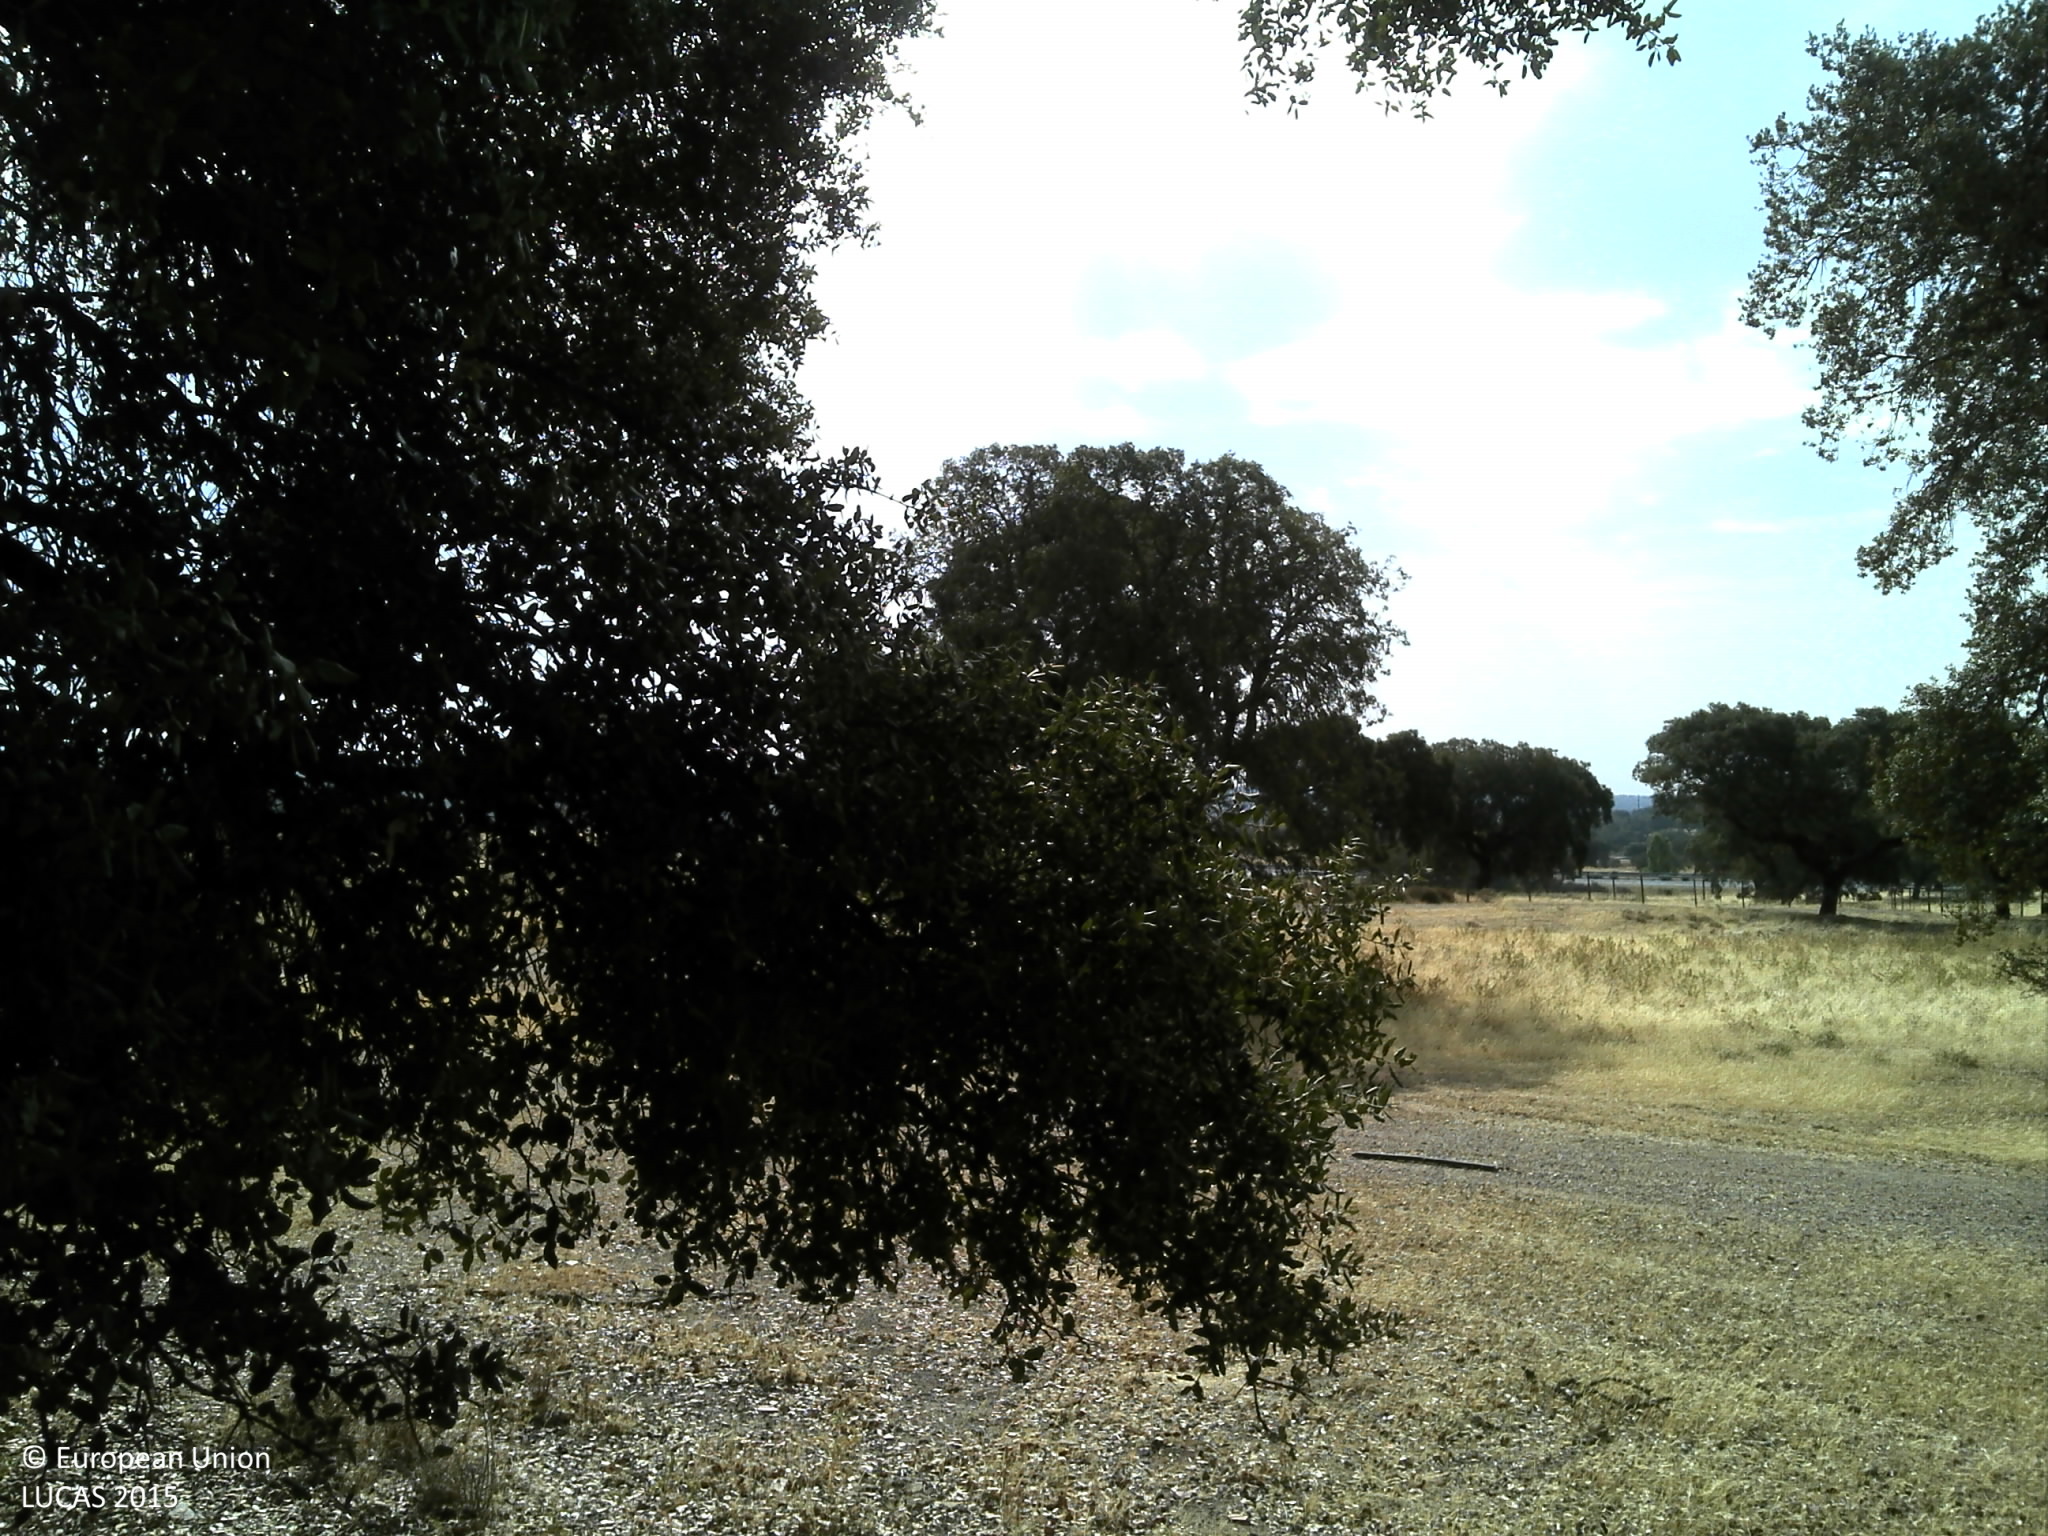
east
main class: Woodland
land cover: Broadleaved woodland
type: broadleaved evergreen forest
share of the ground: 10 - 25 %
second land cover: Grassland without tree/shrub cover
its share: 10 - 25 %
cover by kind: unconsolidated bare surface 80 %, broadleaved forest trees 10 %, herbaceous plants 10 %
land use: Forestry
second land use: Agriculture (excluding fallow land and kitchen gardens)
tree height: > 5 m
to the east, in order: Broadleaved woodland; Grassland without tree/shrub cover; Tracks; Fences; Grassland with sparse tree/shrub cover; Fences; Single bushes/trees; Grassland without tree/shrub cover
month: July
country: PT
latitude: 38.7197
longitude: -7.7861
